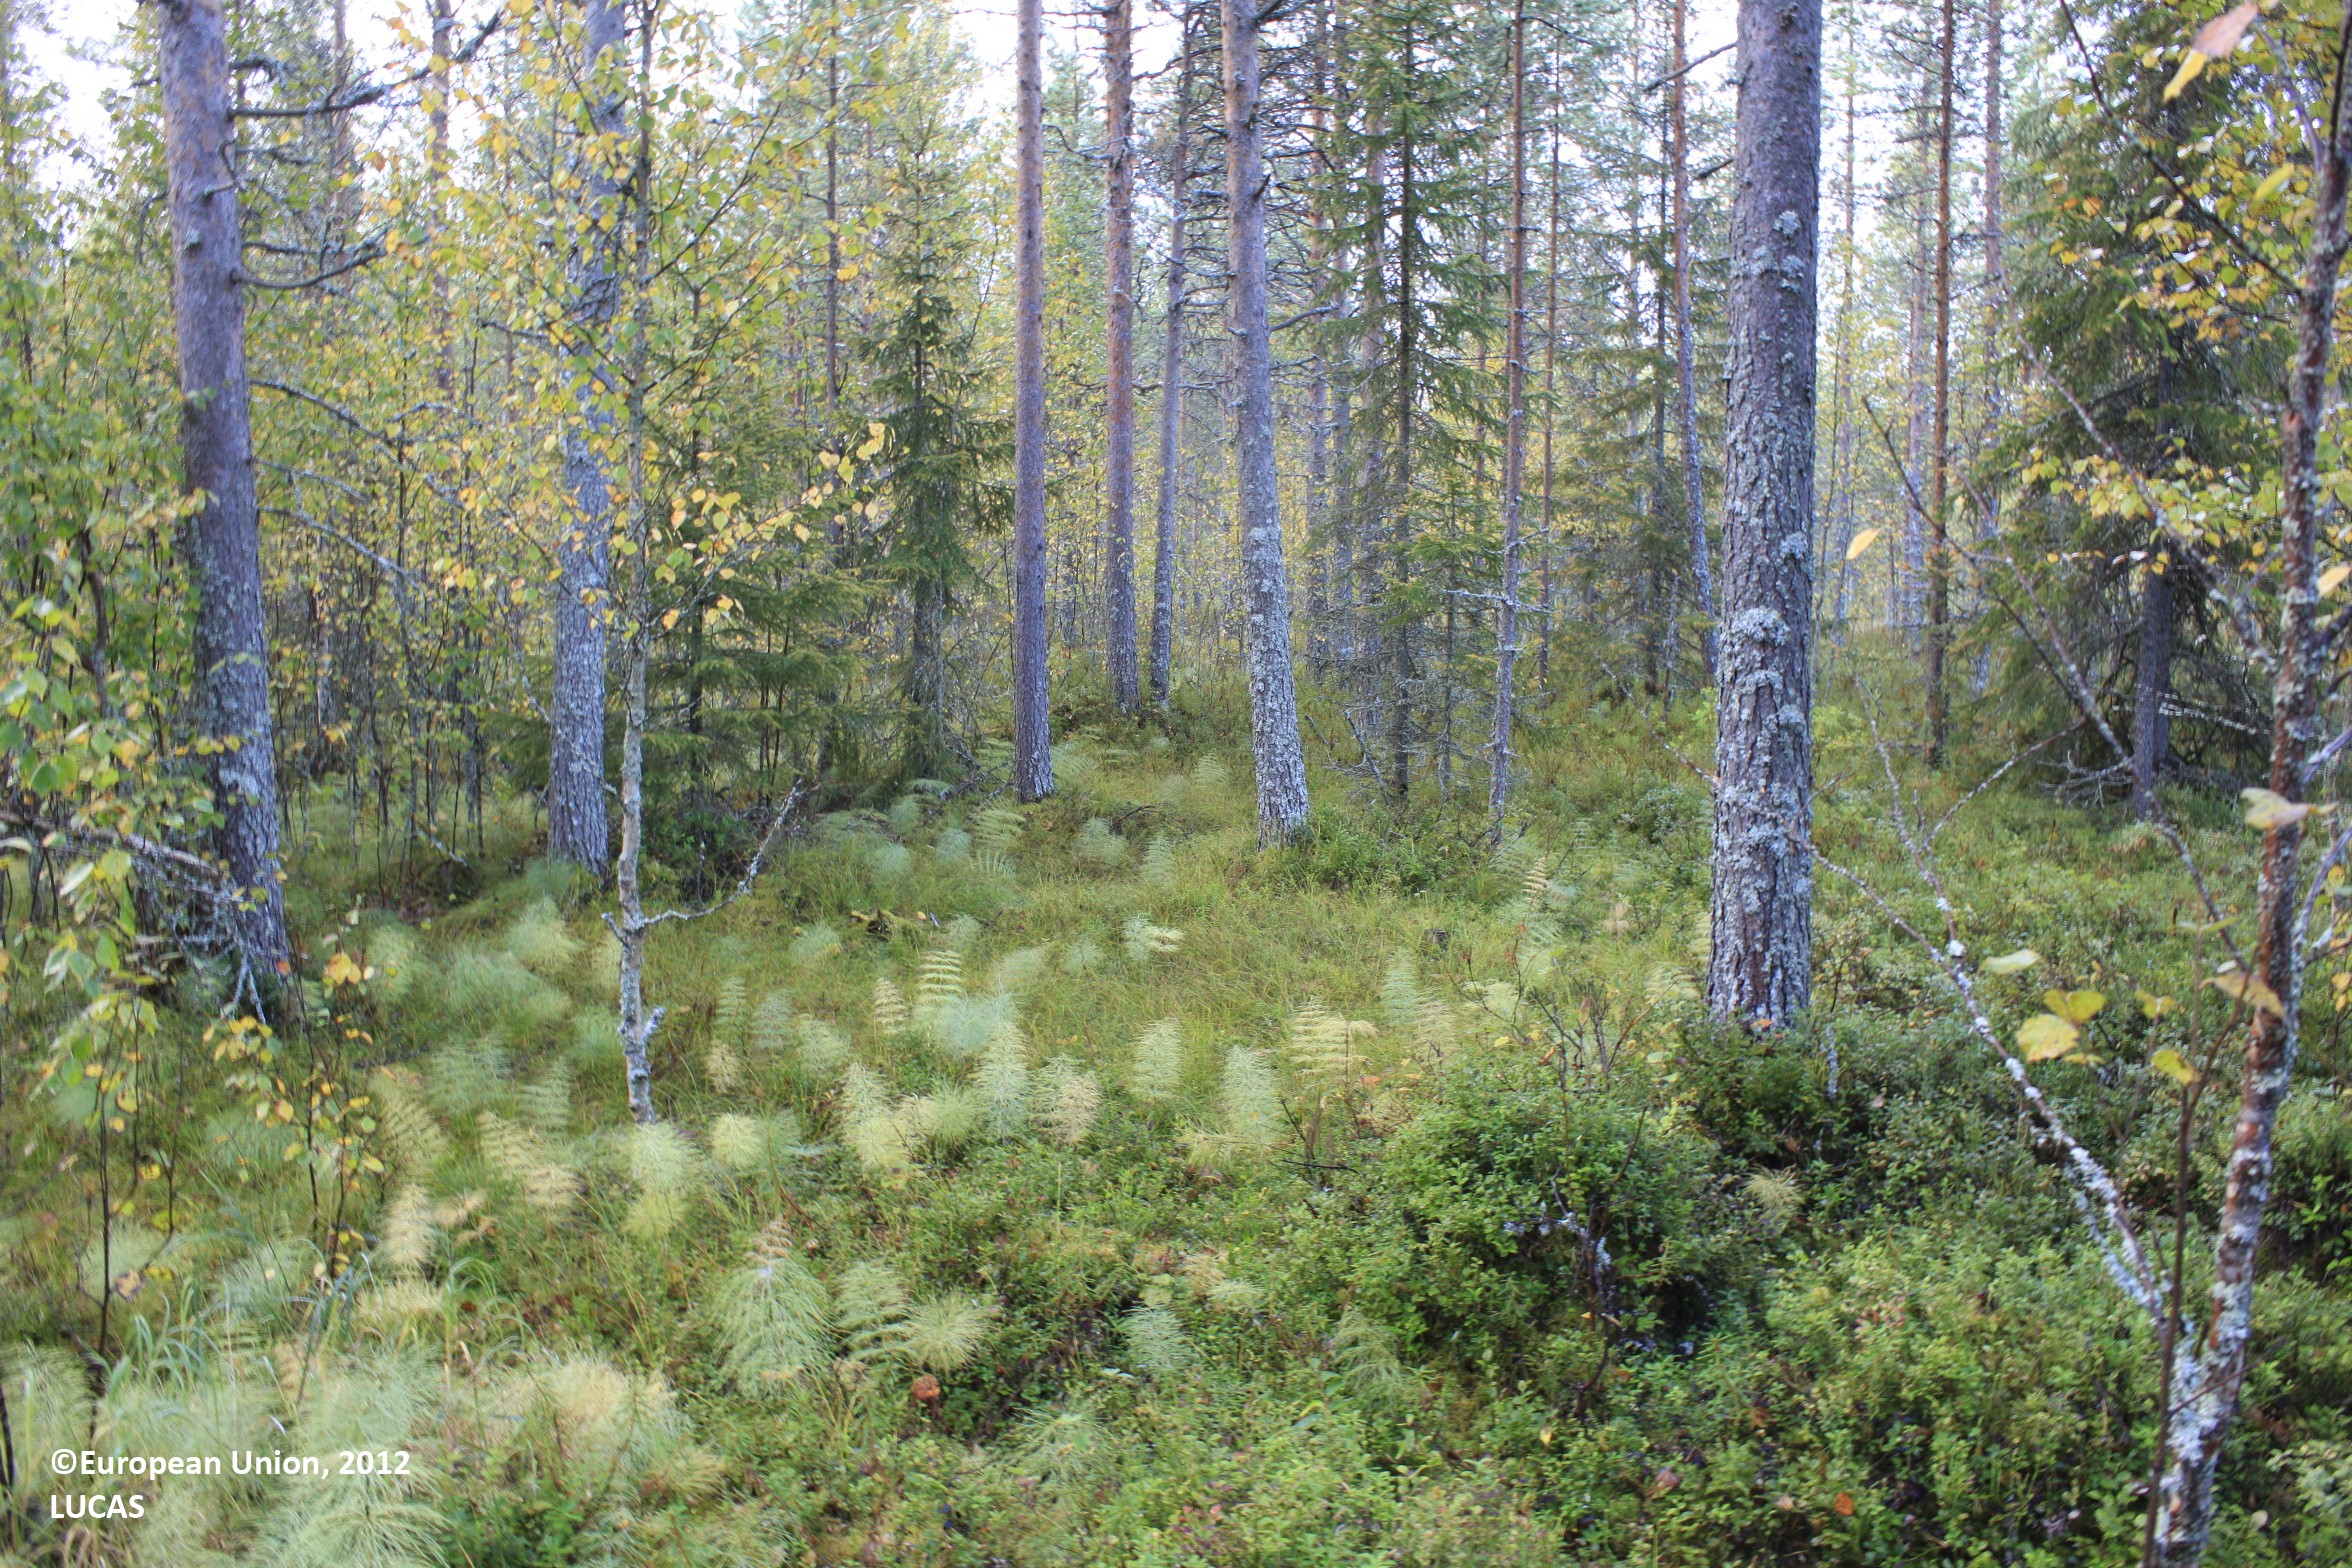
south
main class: Woodland
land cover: Pine dominated mixed woodland
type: boreal forest
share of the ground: 50 - 75 %
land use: Forestry
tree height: > 5 m
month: September
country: FI
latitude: 65.4797
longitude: 26.6246
